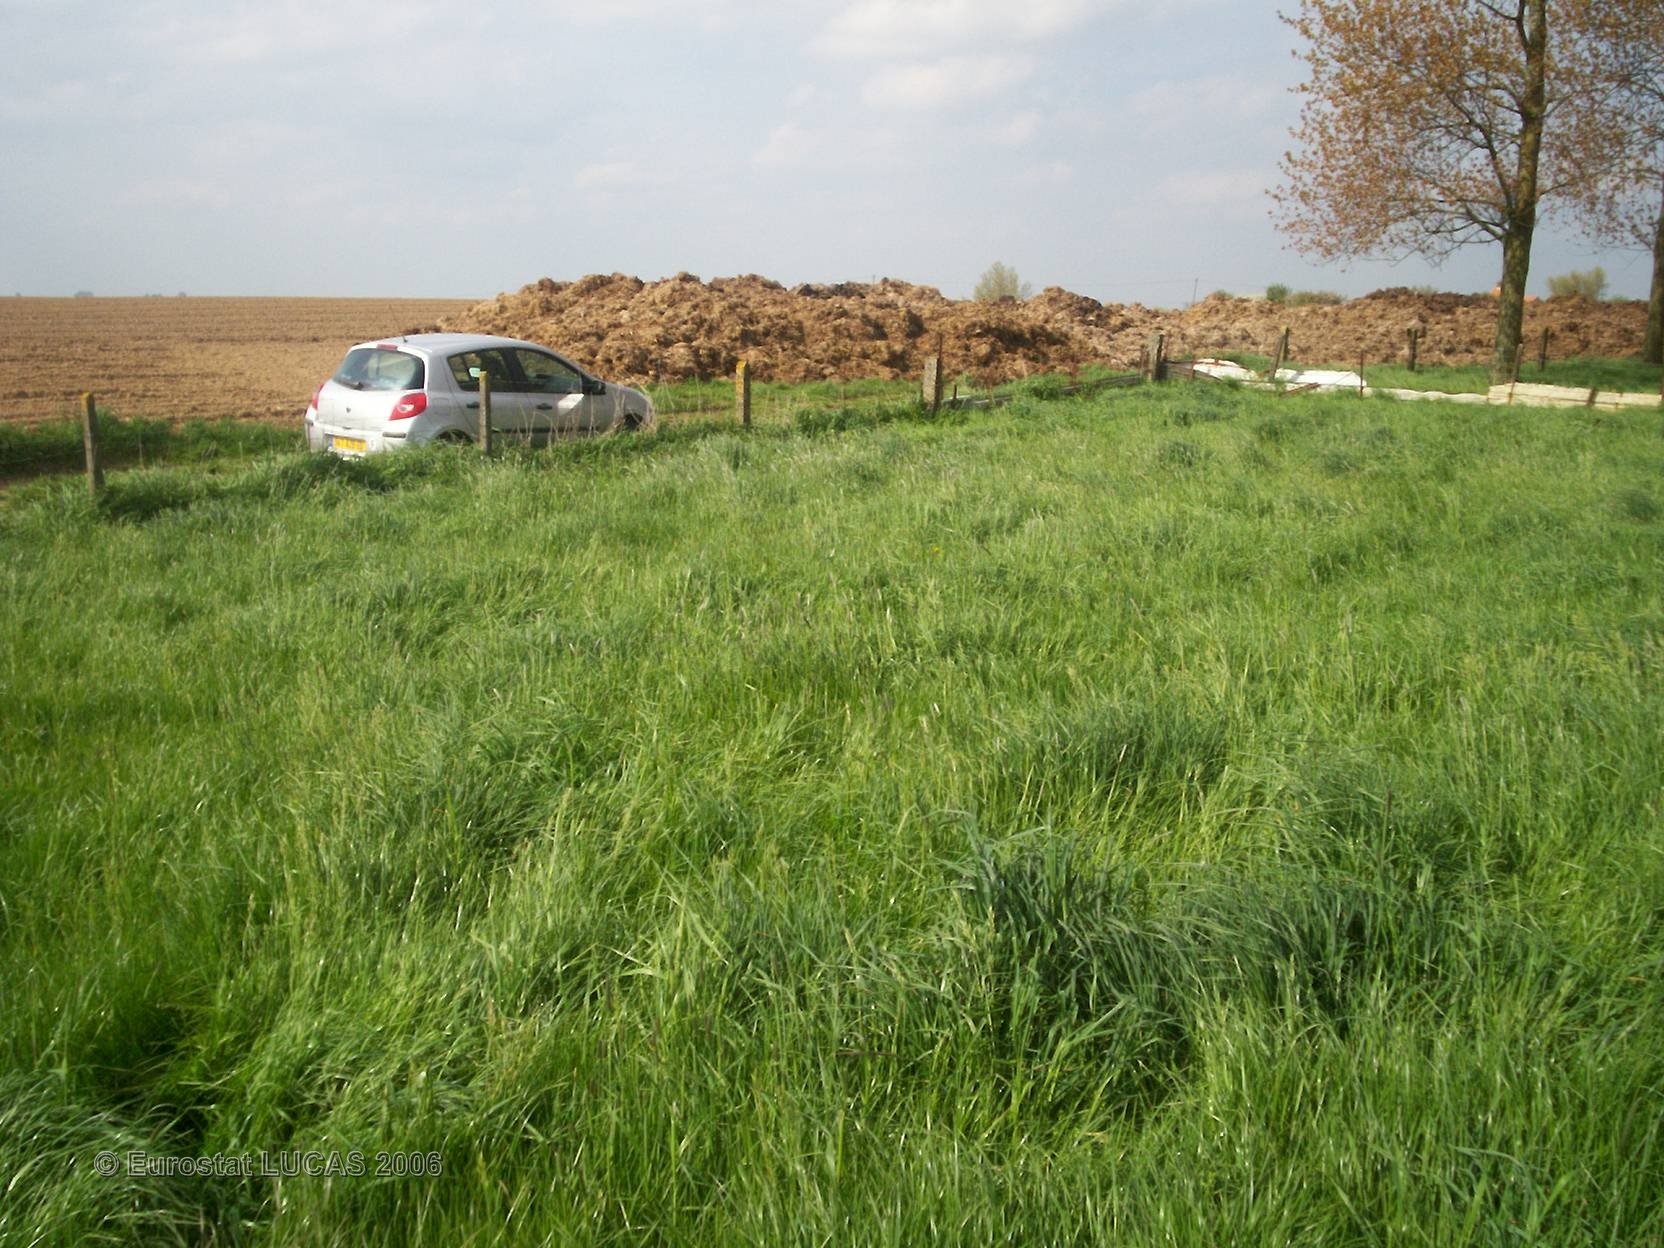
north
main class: Grassland
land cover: Grassland without tree/shrub cover
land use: Agriculture (excluding fallow land and kitchen gardens)
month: May
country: FR
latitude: 50.7724
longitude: 2.5714
